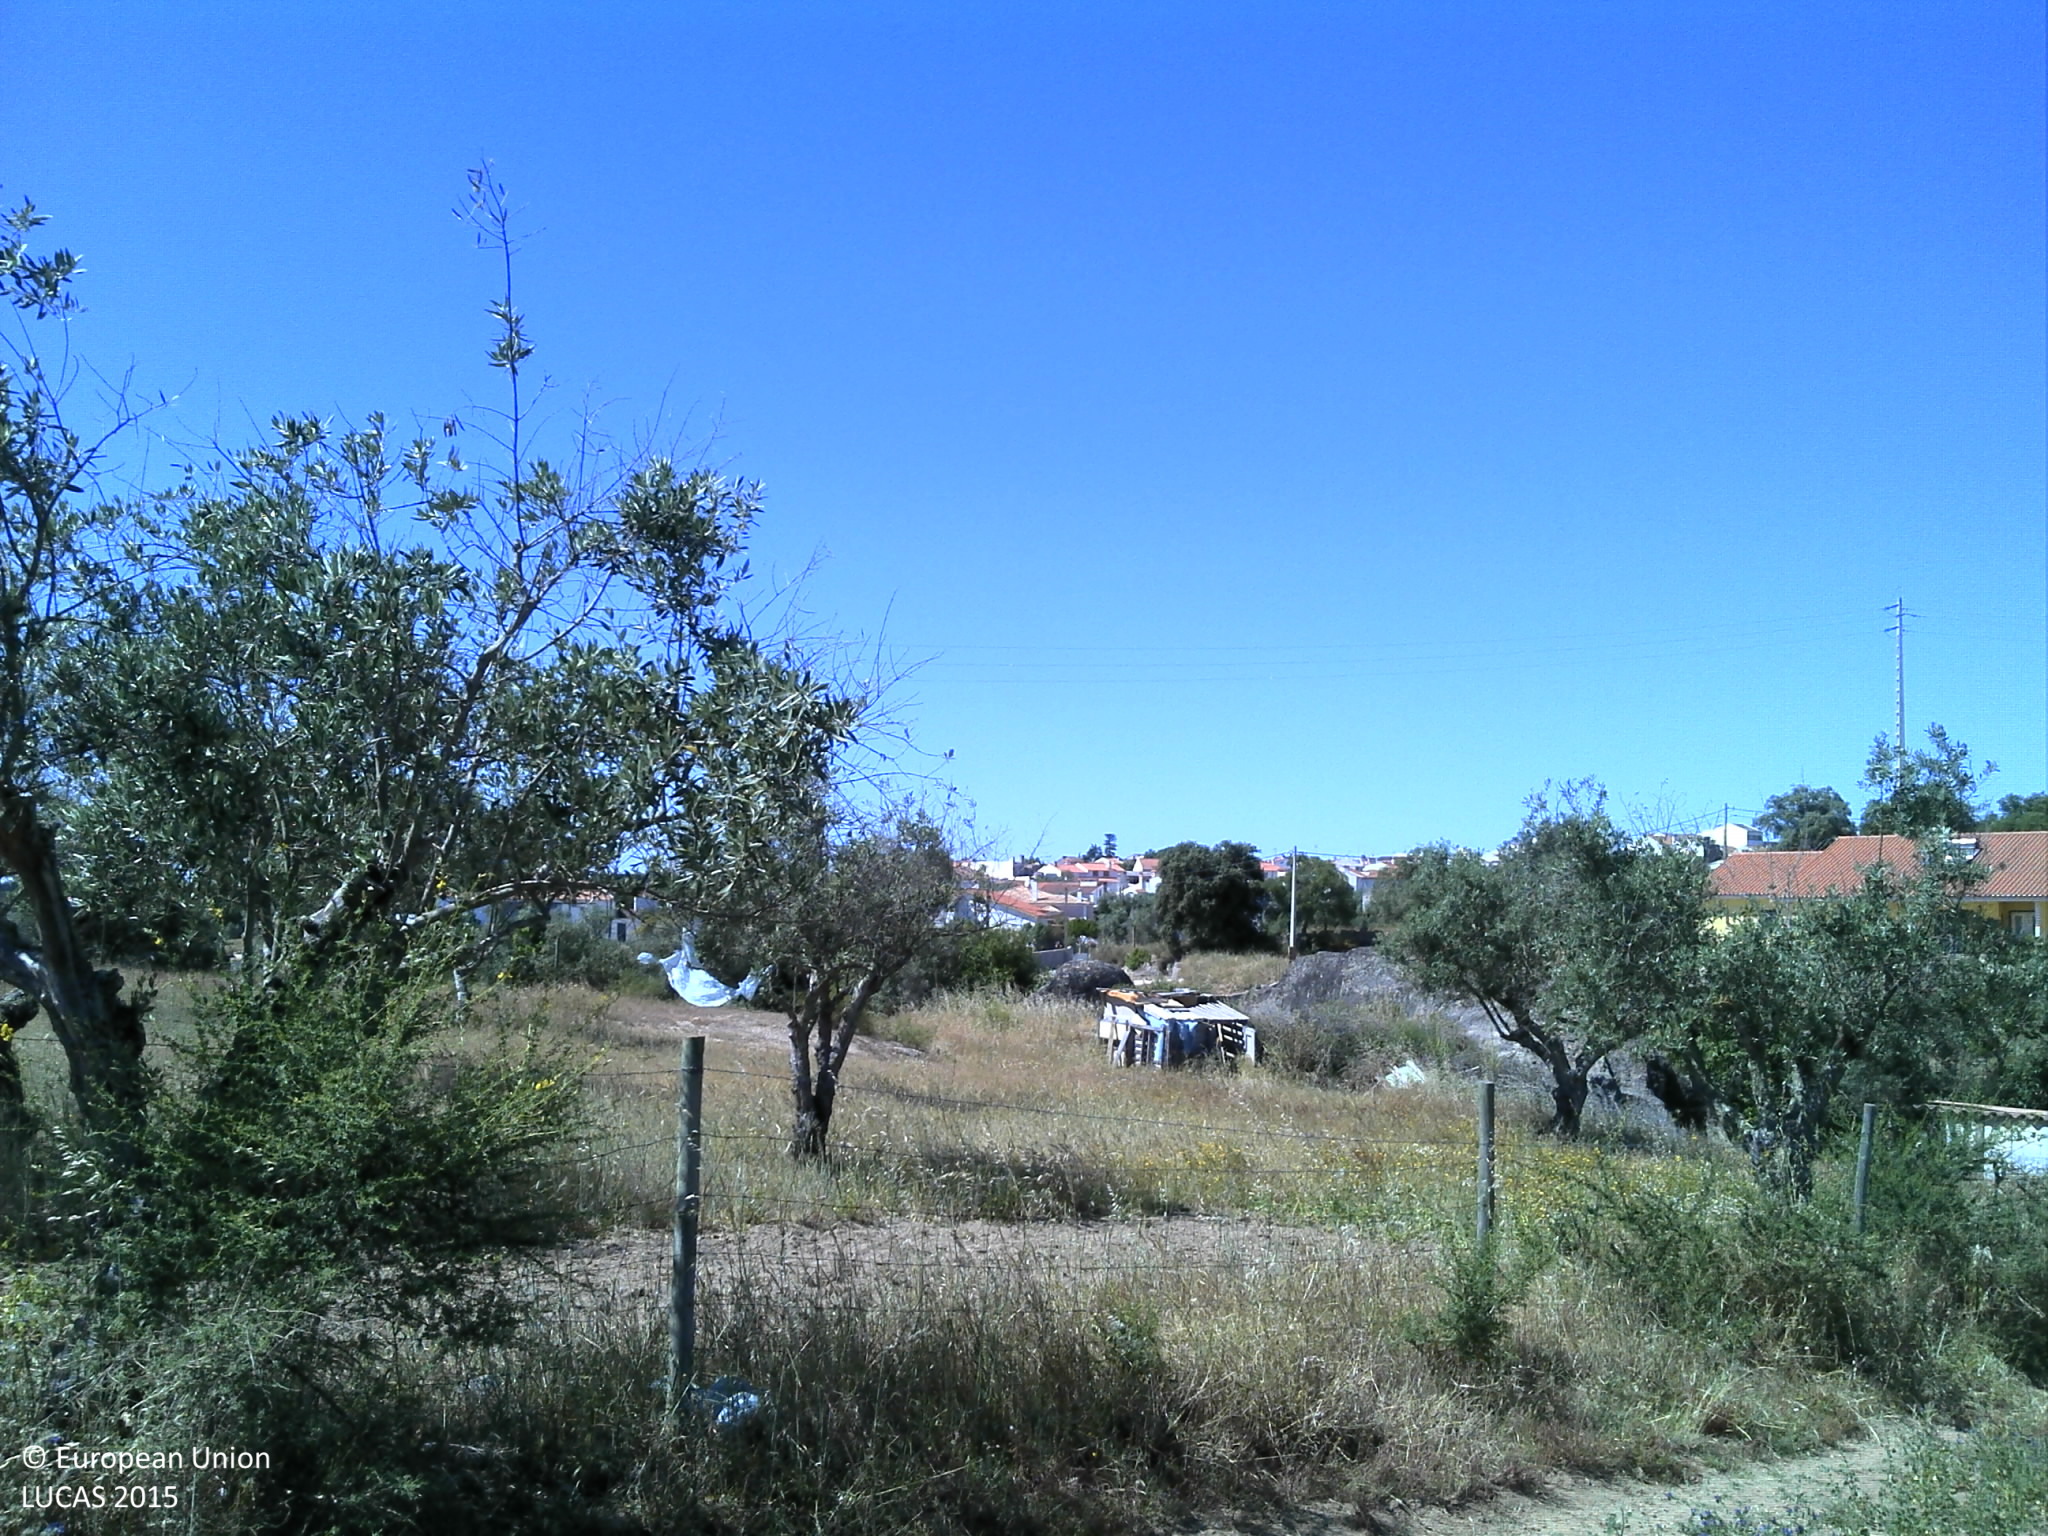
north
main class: Cropland
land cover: Olive groves
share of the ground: 25 - 50 %
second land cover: Grassland without tree/shrub cover
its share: 25 - 50 %
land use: Agriculture (excluding fallow land and kitchen gardens)
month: May
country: PT
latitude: 39.4161
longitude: -7.7170
